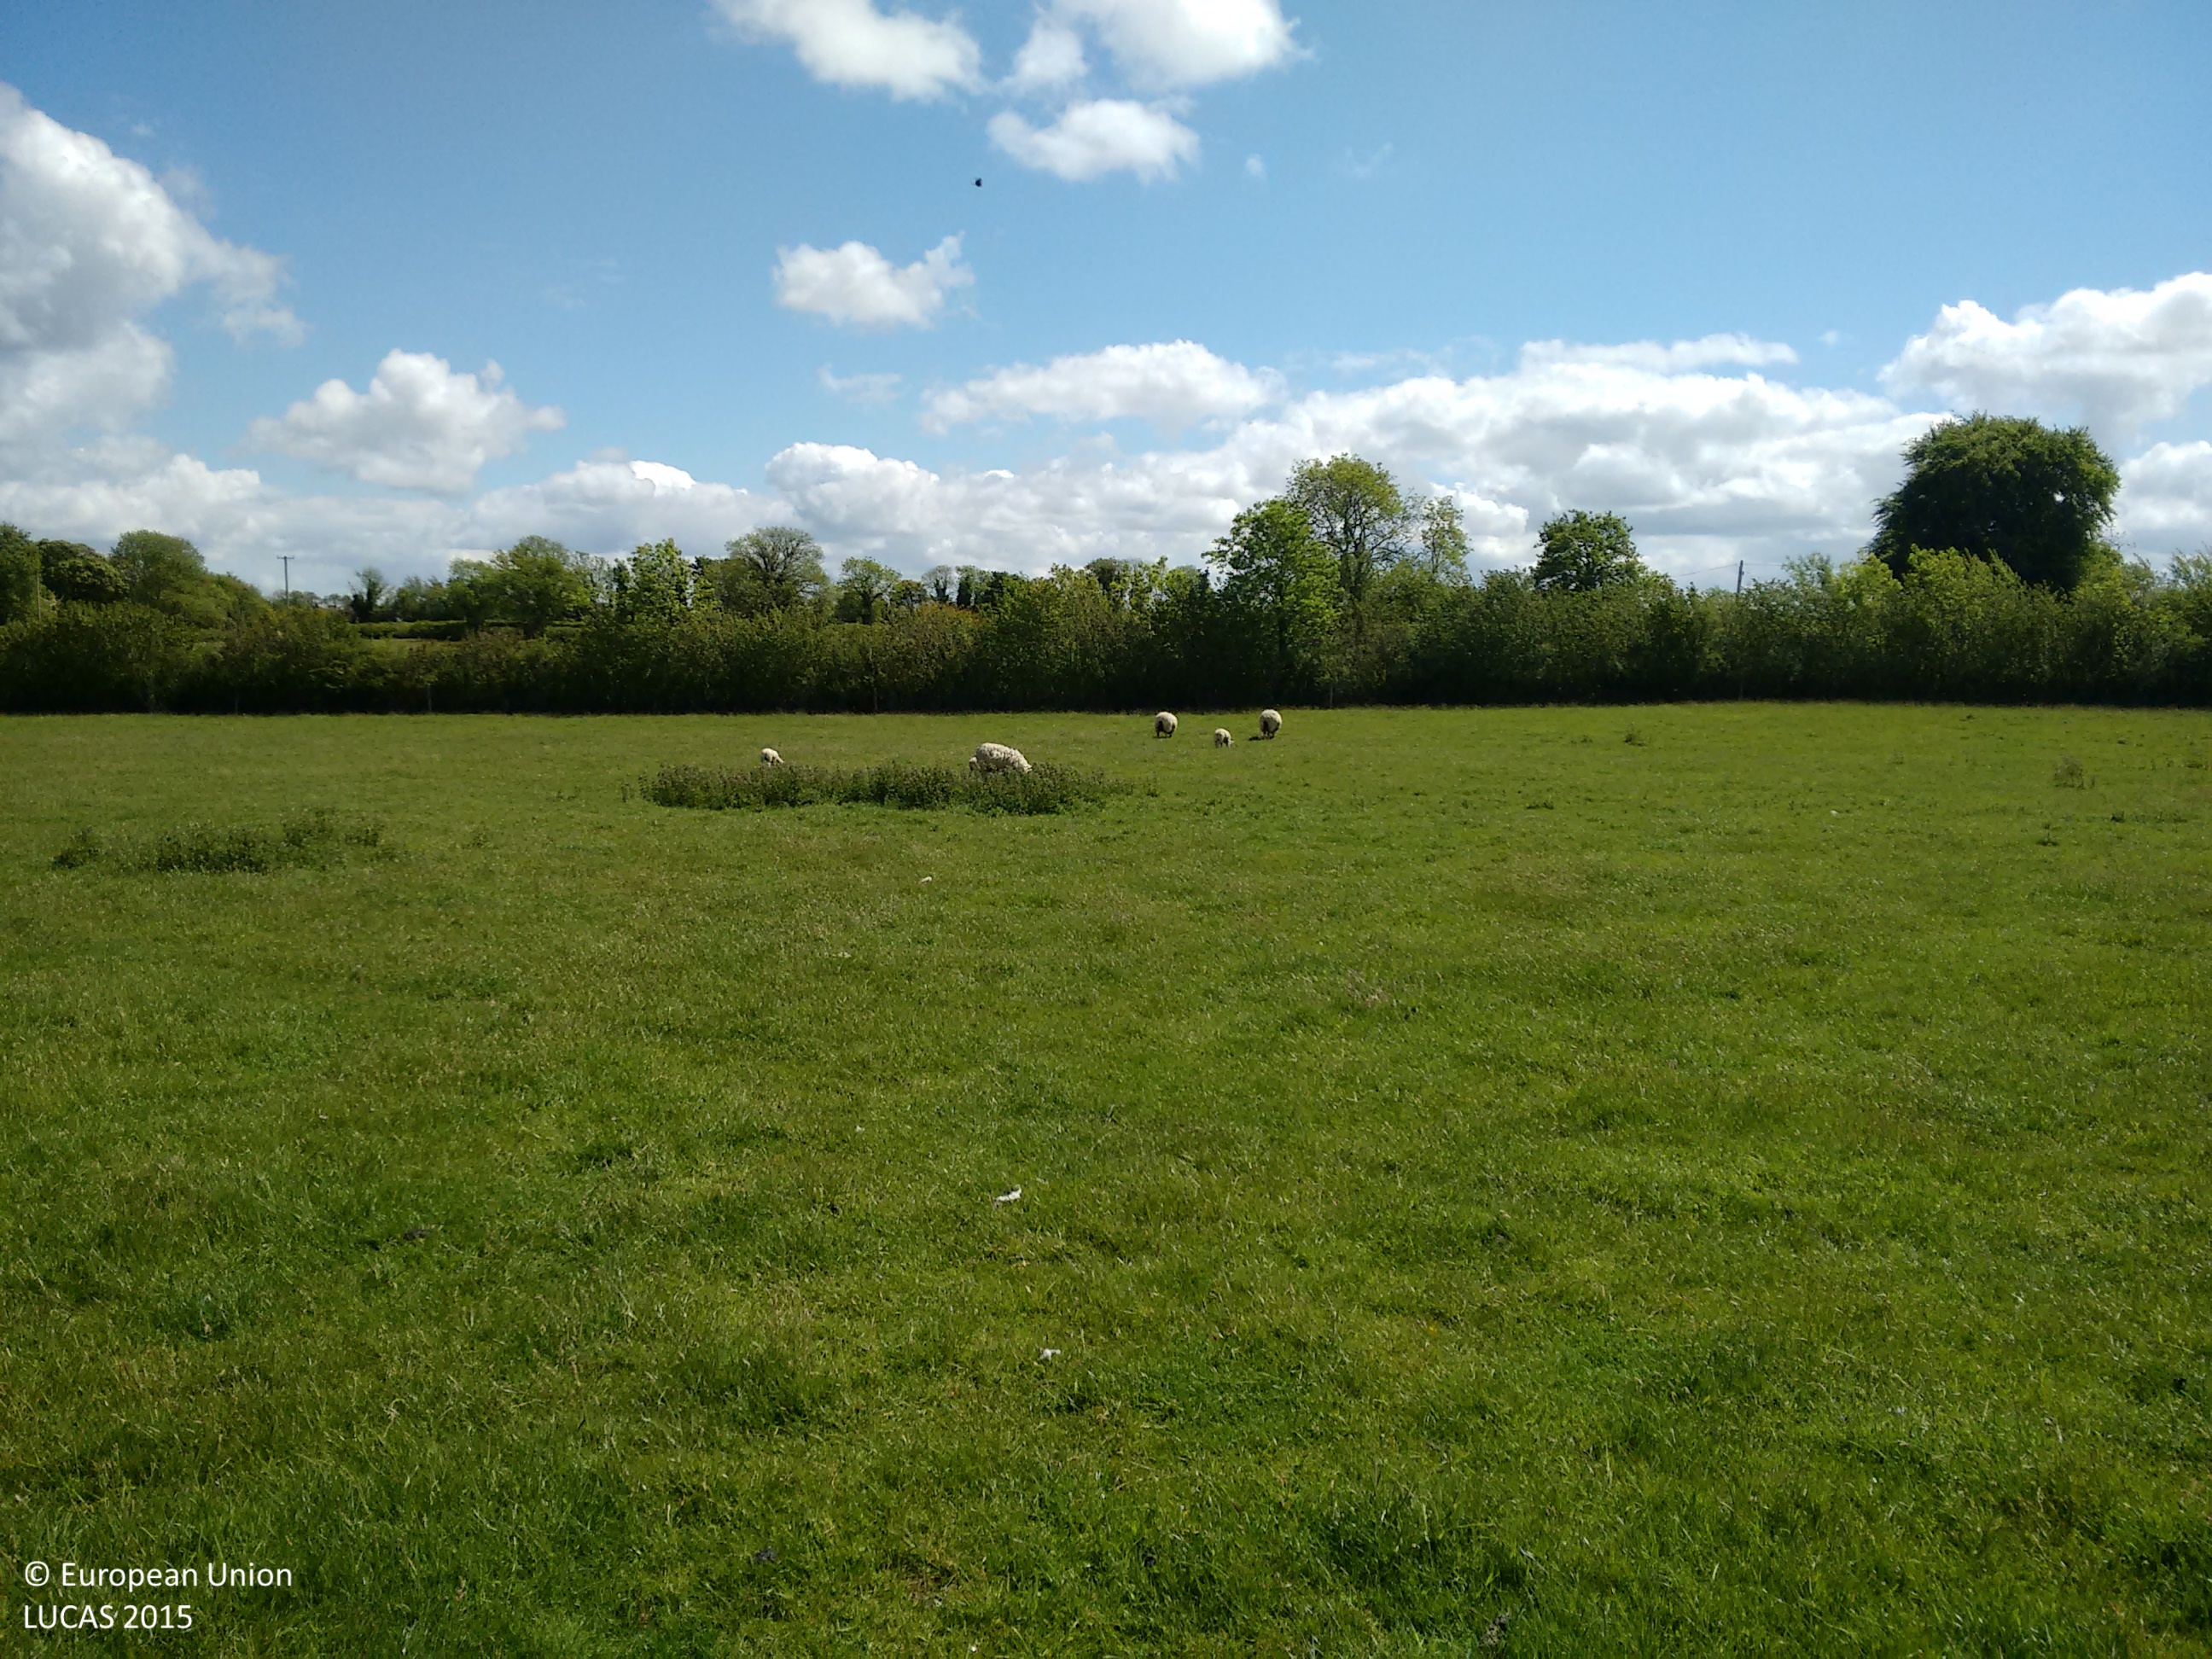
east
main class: Grassland
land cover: Grassland without tree/shrub cover
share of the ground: > 75 %
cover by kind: herbaceous plants 100 %
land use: Agriculture (excluding fallow land and kitchen gardens)
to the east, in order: Grassland without tree/shrub cover; Managed hedges; Grassland without tree/shrub cover; Managed hedges; Grass margins; Paved roads, cycling and walking lanes; Grass margins; Electric lines; Grass margins; Electric lines; Grass margins; Managed hedges; Common wheat
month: June
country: IE
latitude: 53.4400
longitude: -6.9872
